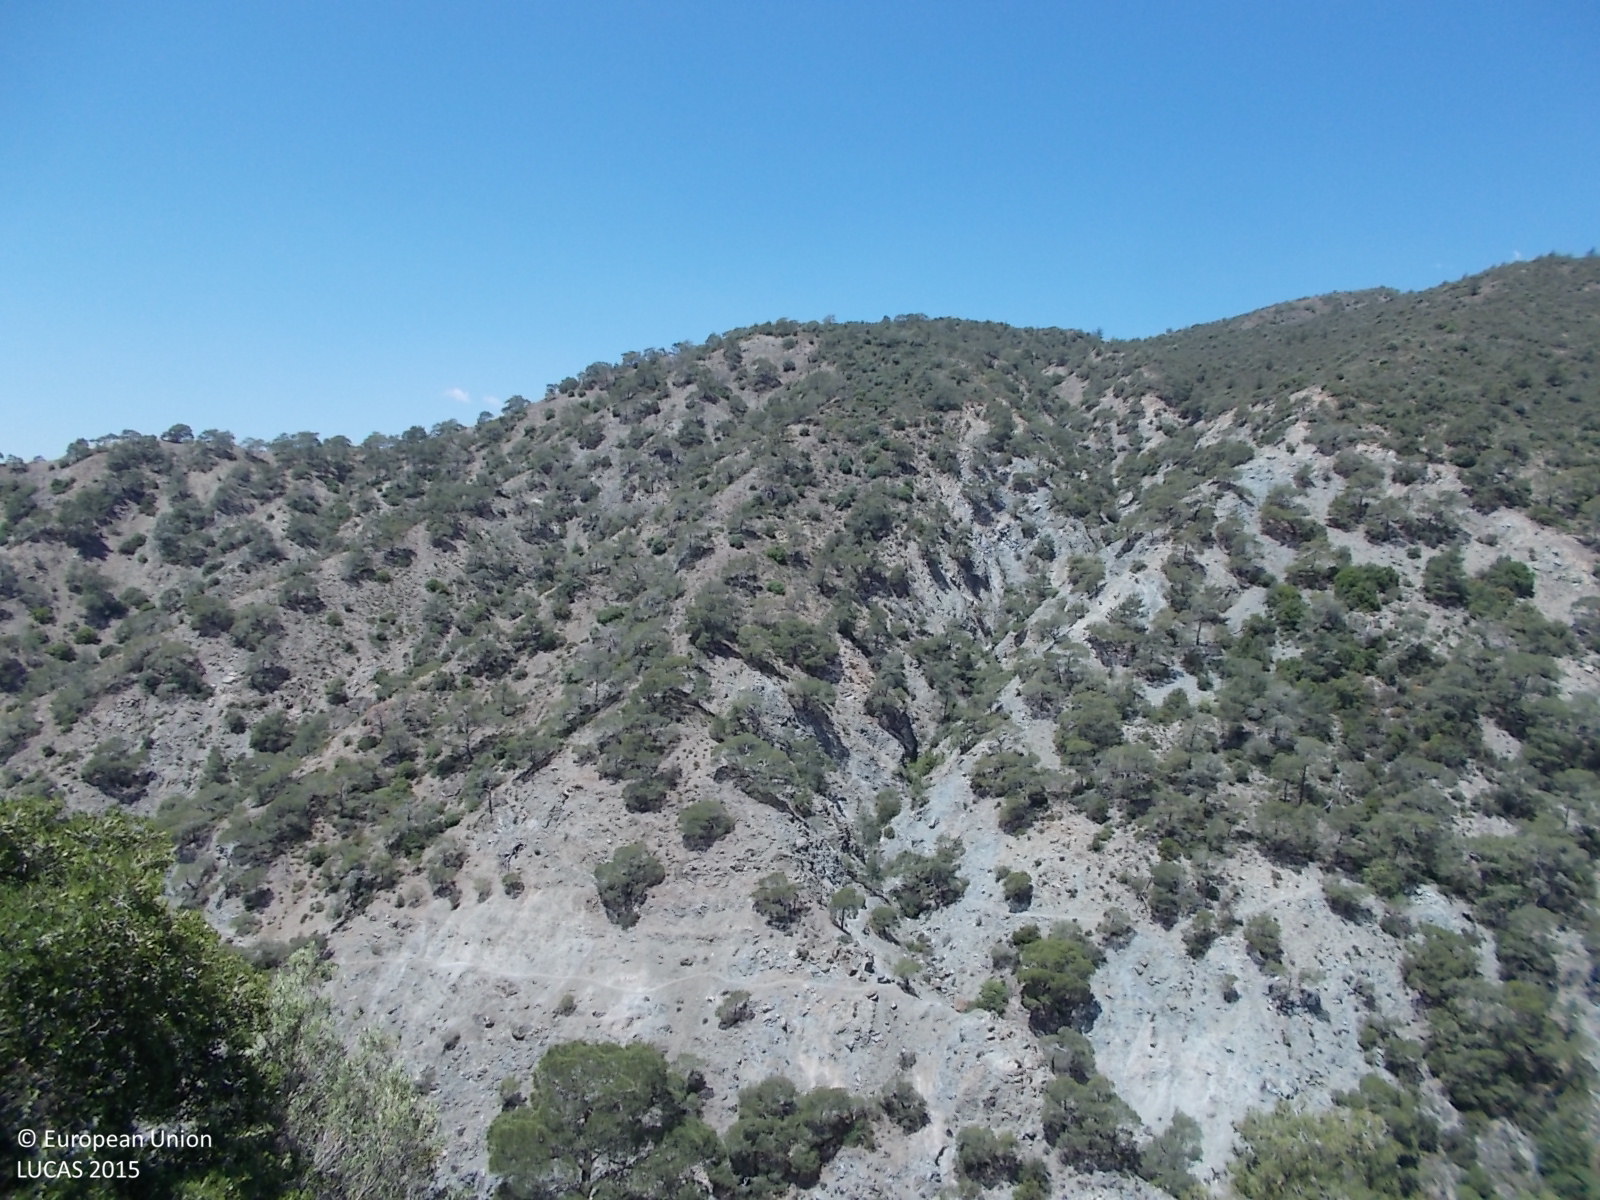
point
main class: Woodland
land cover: Pine dominated coniferous woodland
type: coniferous forest of the mediterranean region
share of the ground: 25 - 50 %
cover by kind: unconsolidated bare surface 55 %, coniferous forest trees 45 %
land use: Forestry
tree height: > 5 m
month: May
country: CY
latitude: 34.8063
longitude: 33.0252
